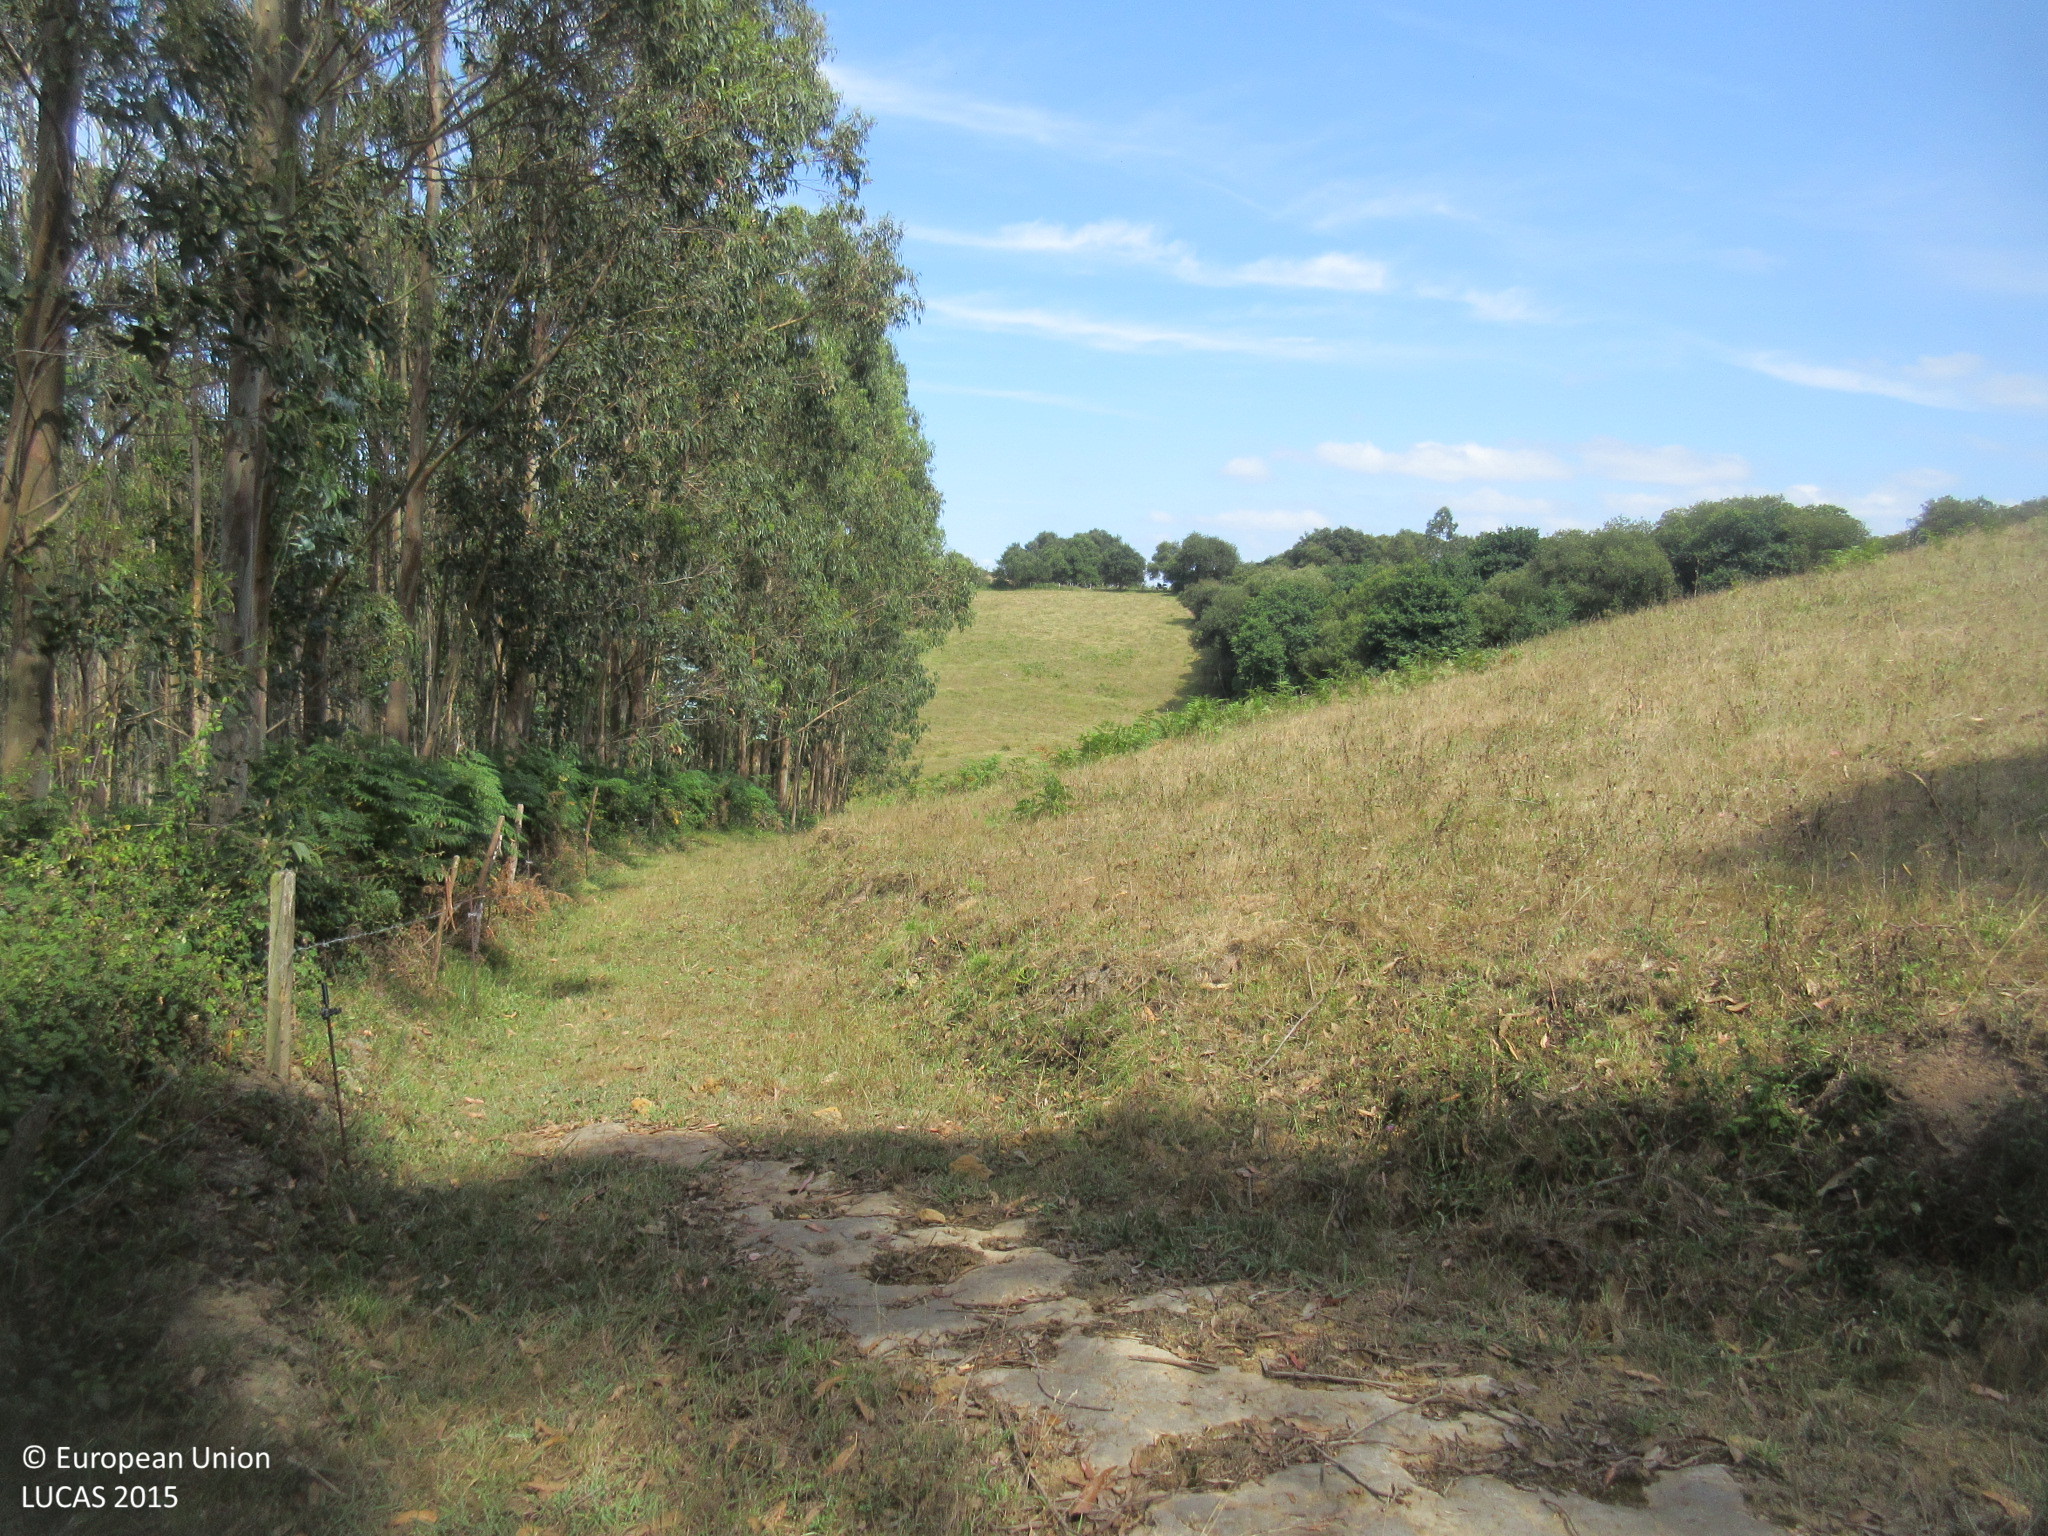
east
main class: Shrubland
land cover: Shrubland with sparse tree cover
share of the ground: > 75 %
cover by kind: shrubs 95 %, broadleaved forest trees 5 %
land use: Forestry
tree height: < 5 m
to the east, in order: Shrubland with sparse tree cover; Broadleaved woodland; Fences; Grassland without tree/shrub cover
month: July
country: ES
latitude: 43.3812
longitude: -4.2382
